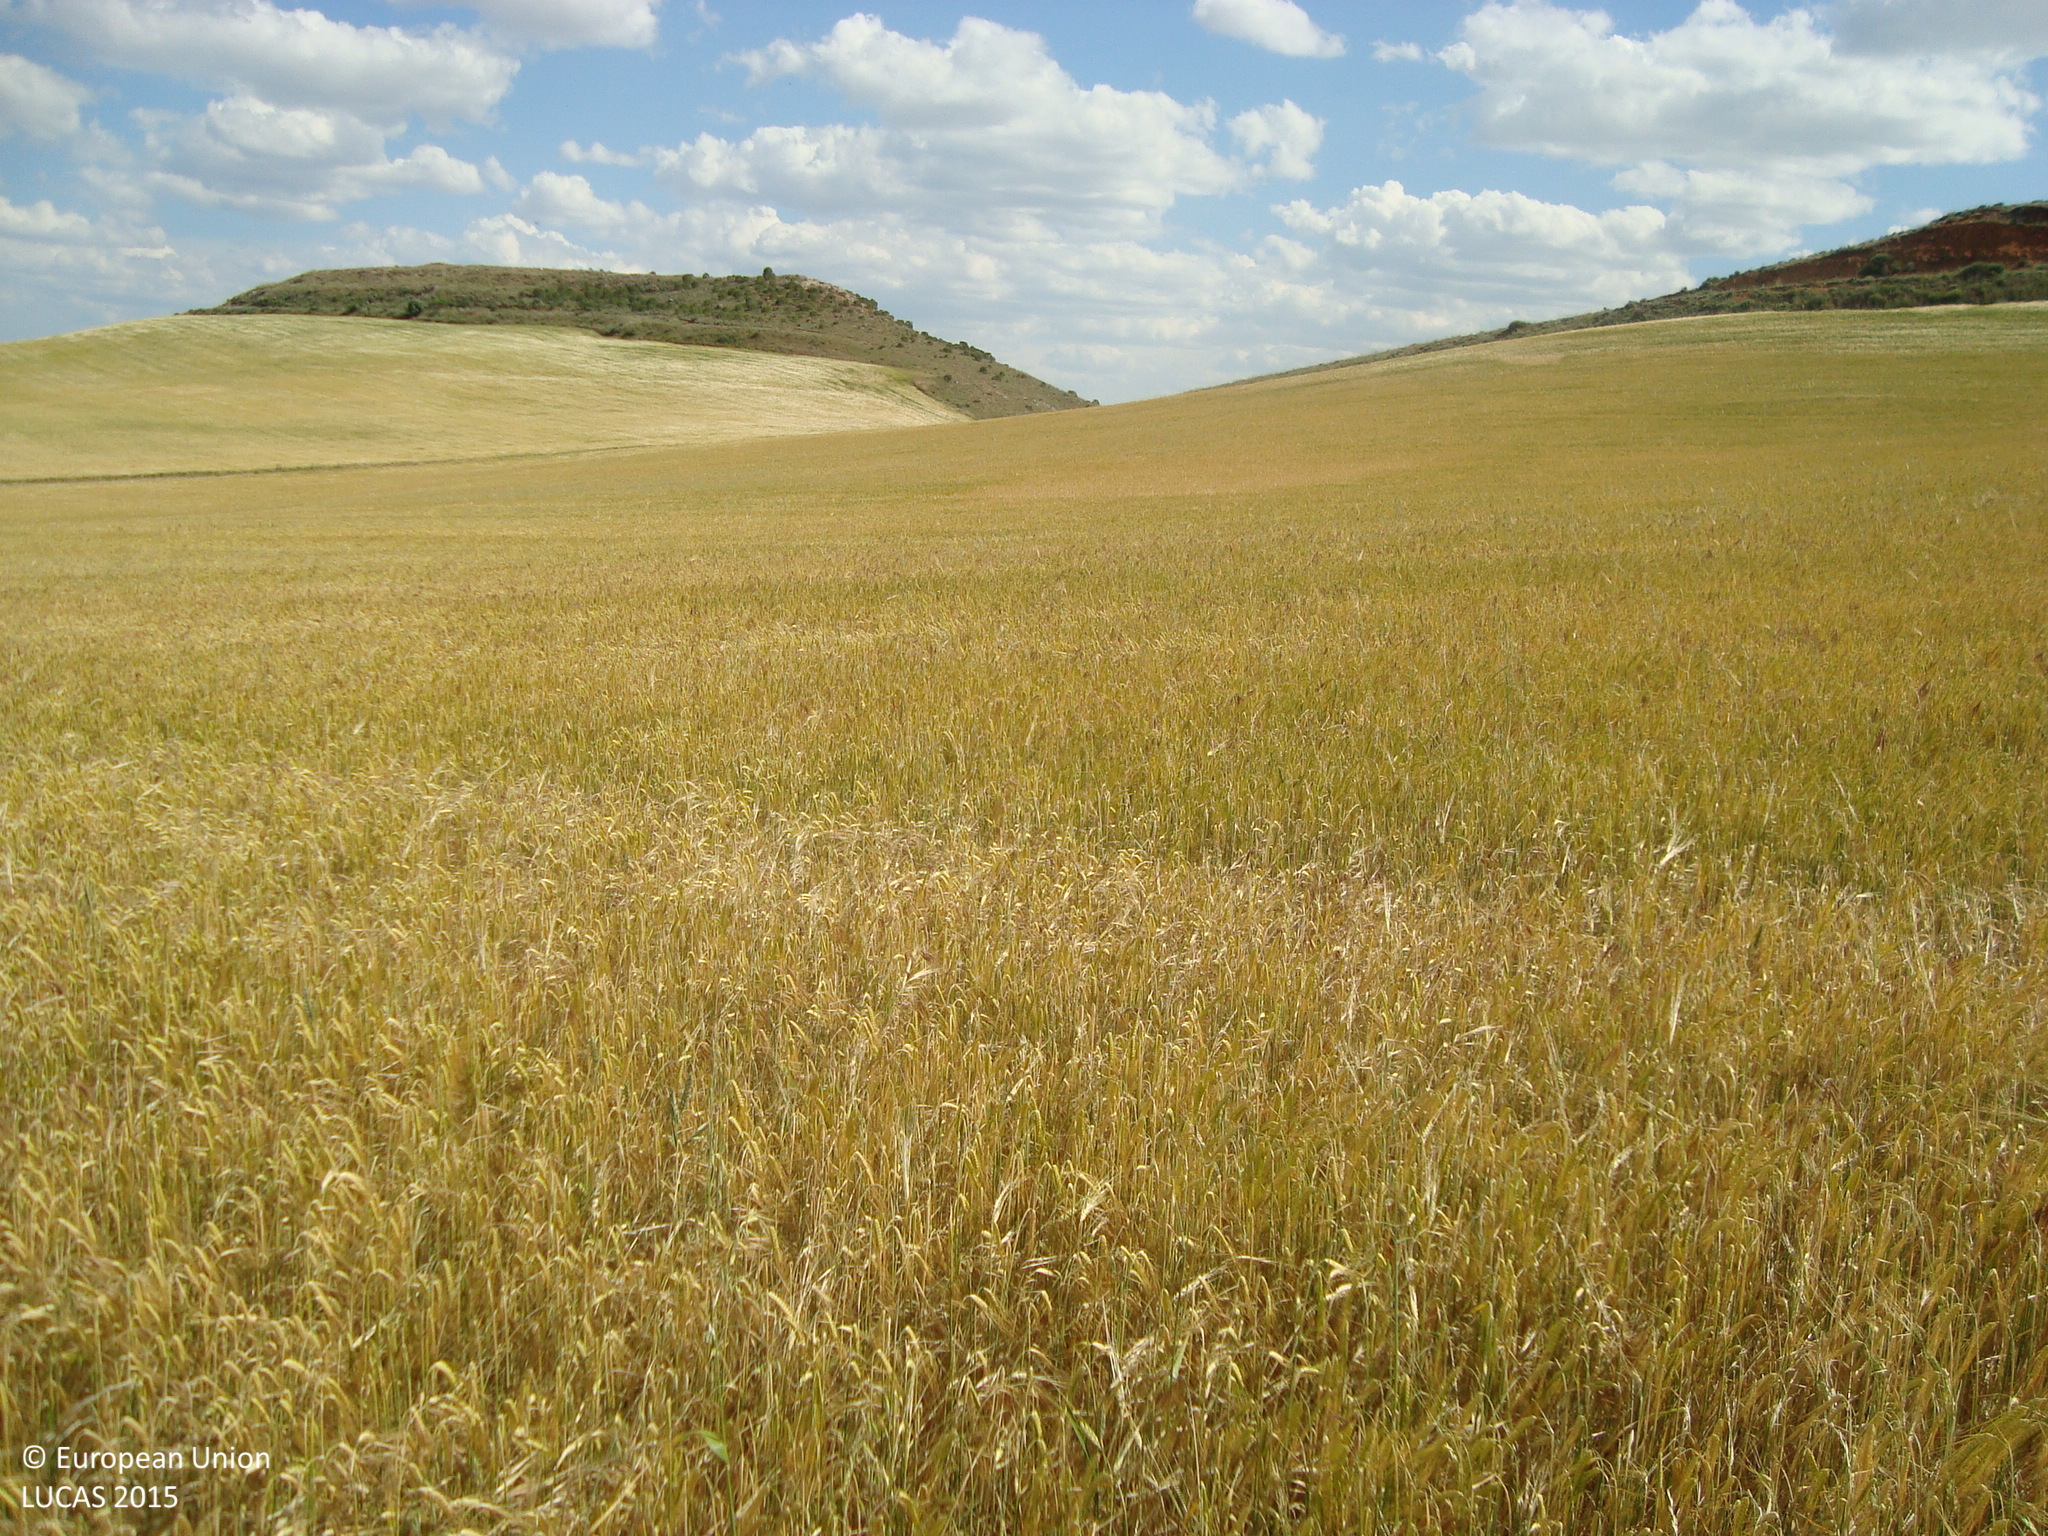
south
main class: Cropland
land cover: Barley
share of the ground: > 75 %
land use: Agriculture (excluding fallow land and kitchen gardens)
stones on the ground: < 10 %
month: May
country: ES
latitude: 41.5838
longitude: -4.0066
